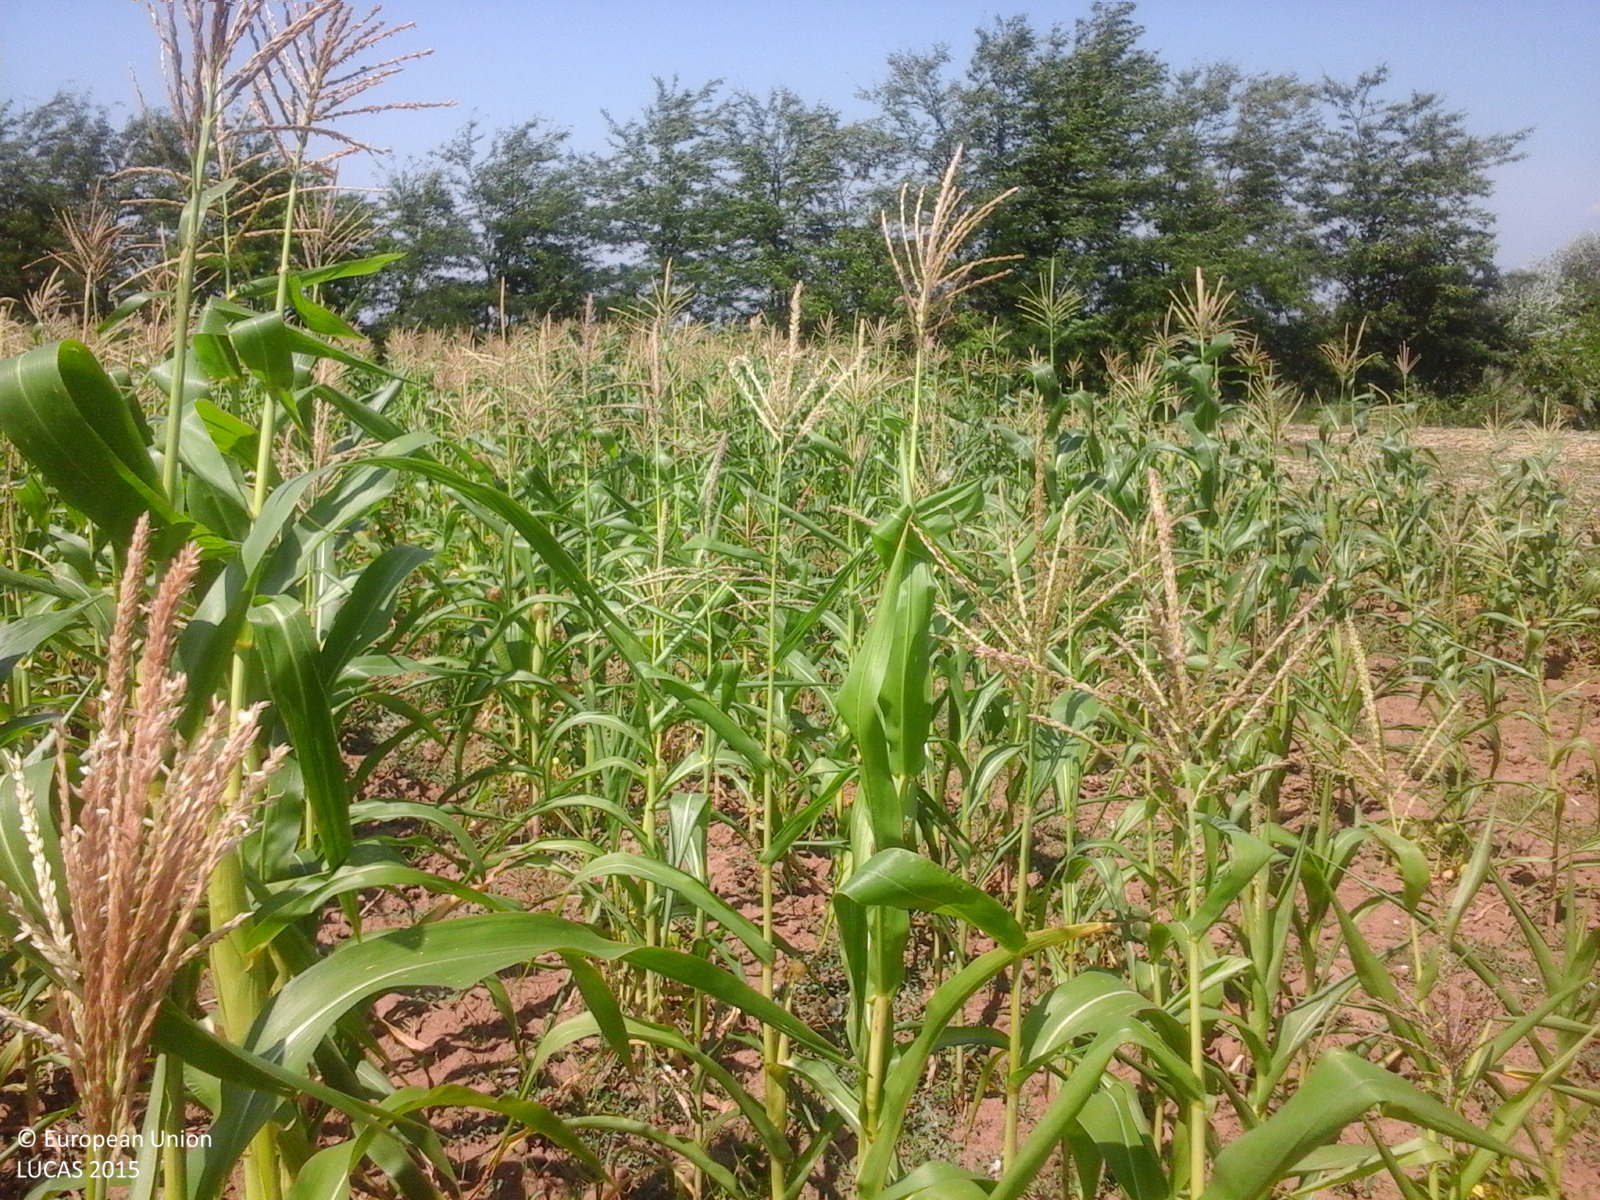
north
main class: Cropland
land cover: Maize
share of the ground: > 75 %
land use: Agriculture (excluding fallow land and kitchen gardens)
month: July
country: RO
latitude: 45.9975
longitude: 27.2859
